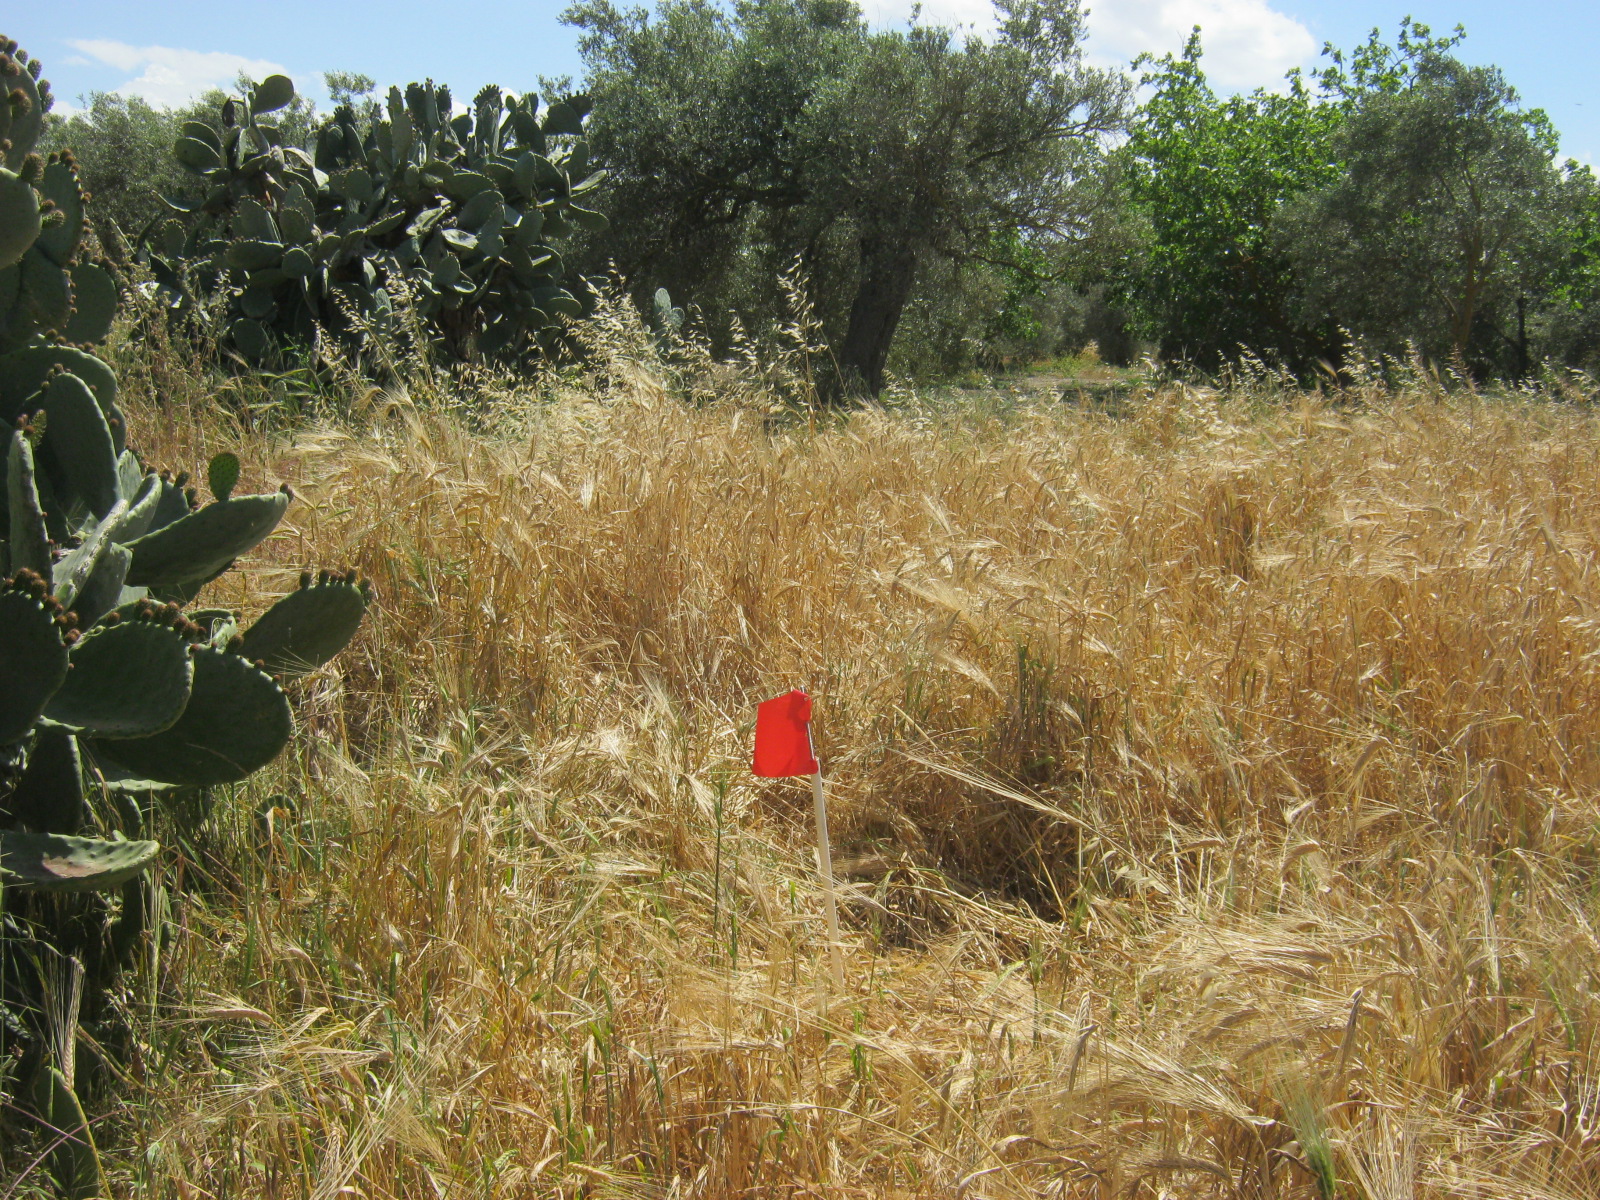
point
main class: Cropland
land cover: Mixed cereals for fodder
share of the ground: > 75 %
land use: Agriculture (excluding fallow land and kitchen gardens)
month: May
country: CY
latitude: 35.1418
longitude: 33.1799
